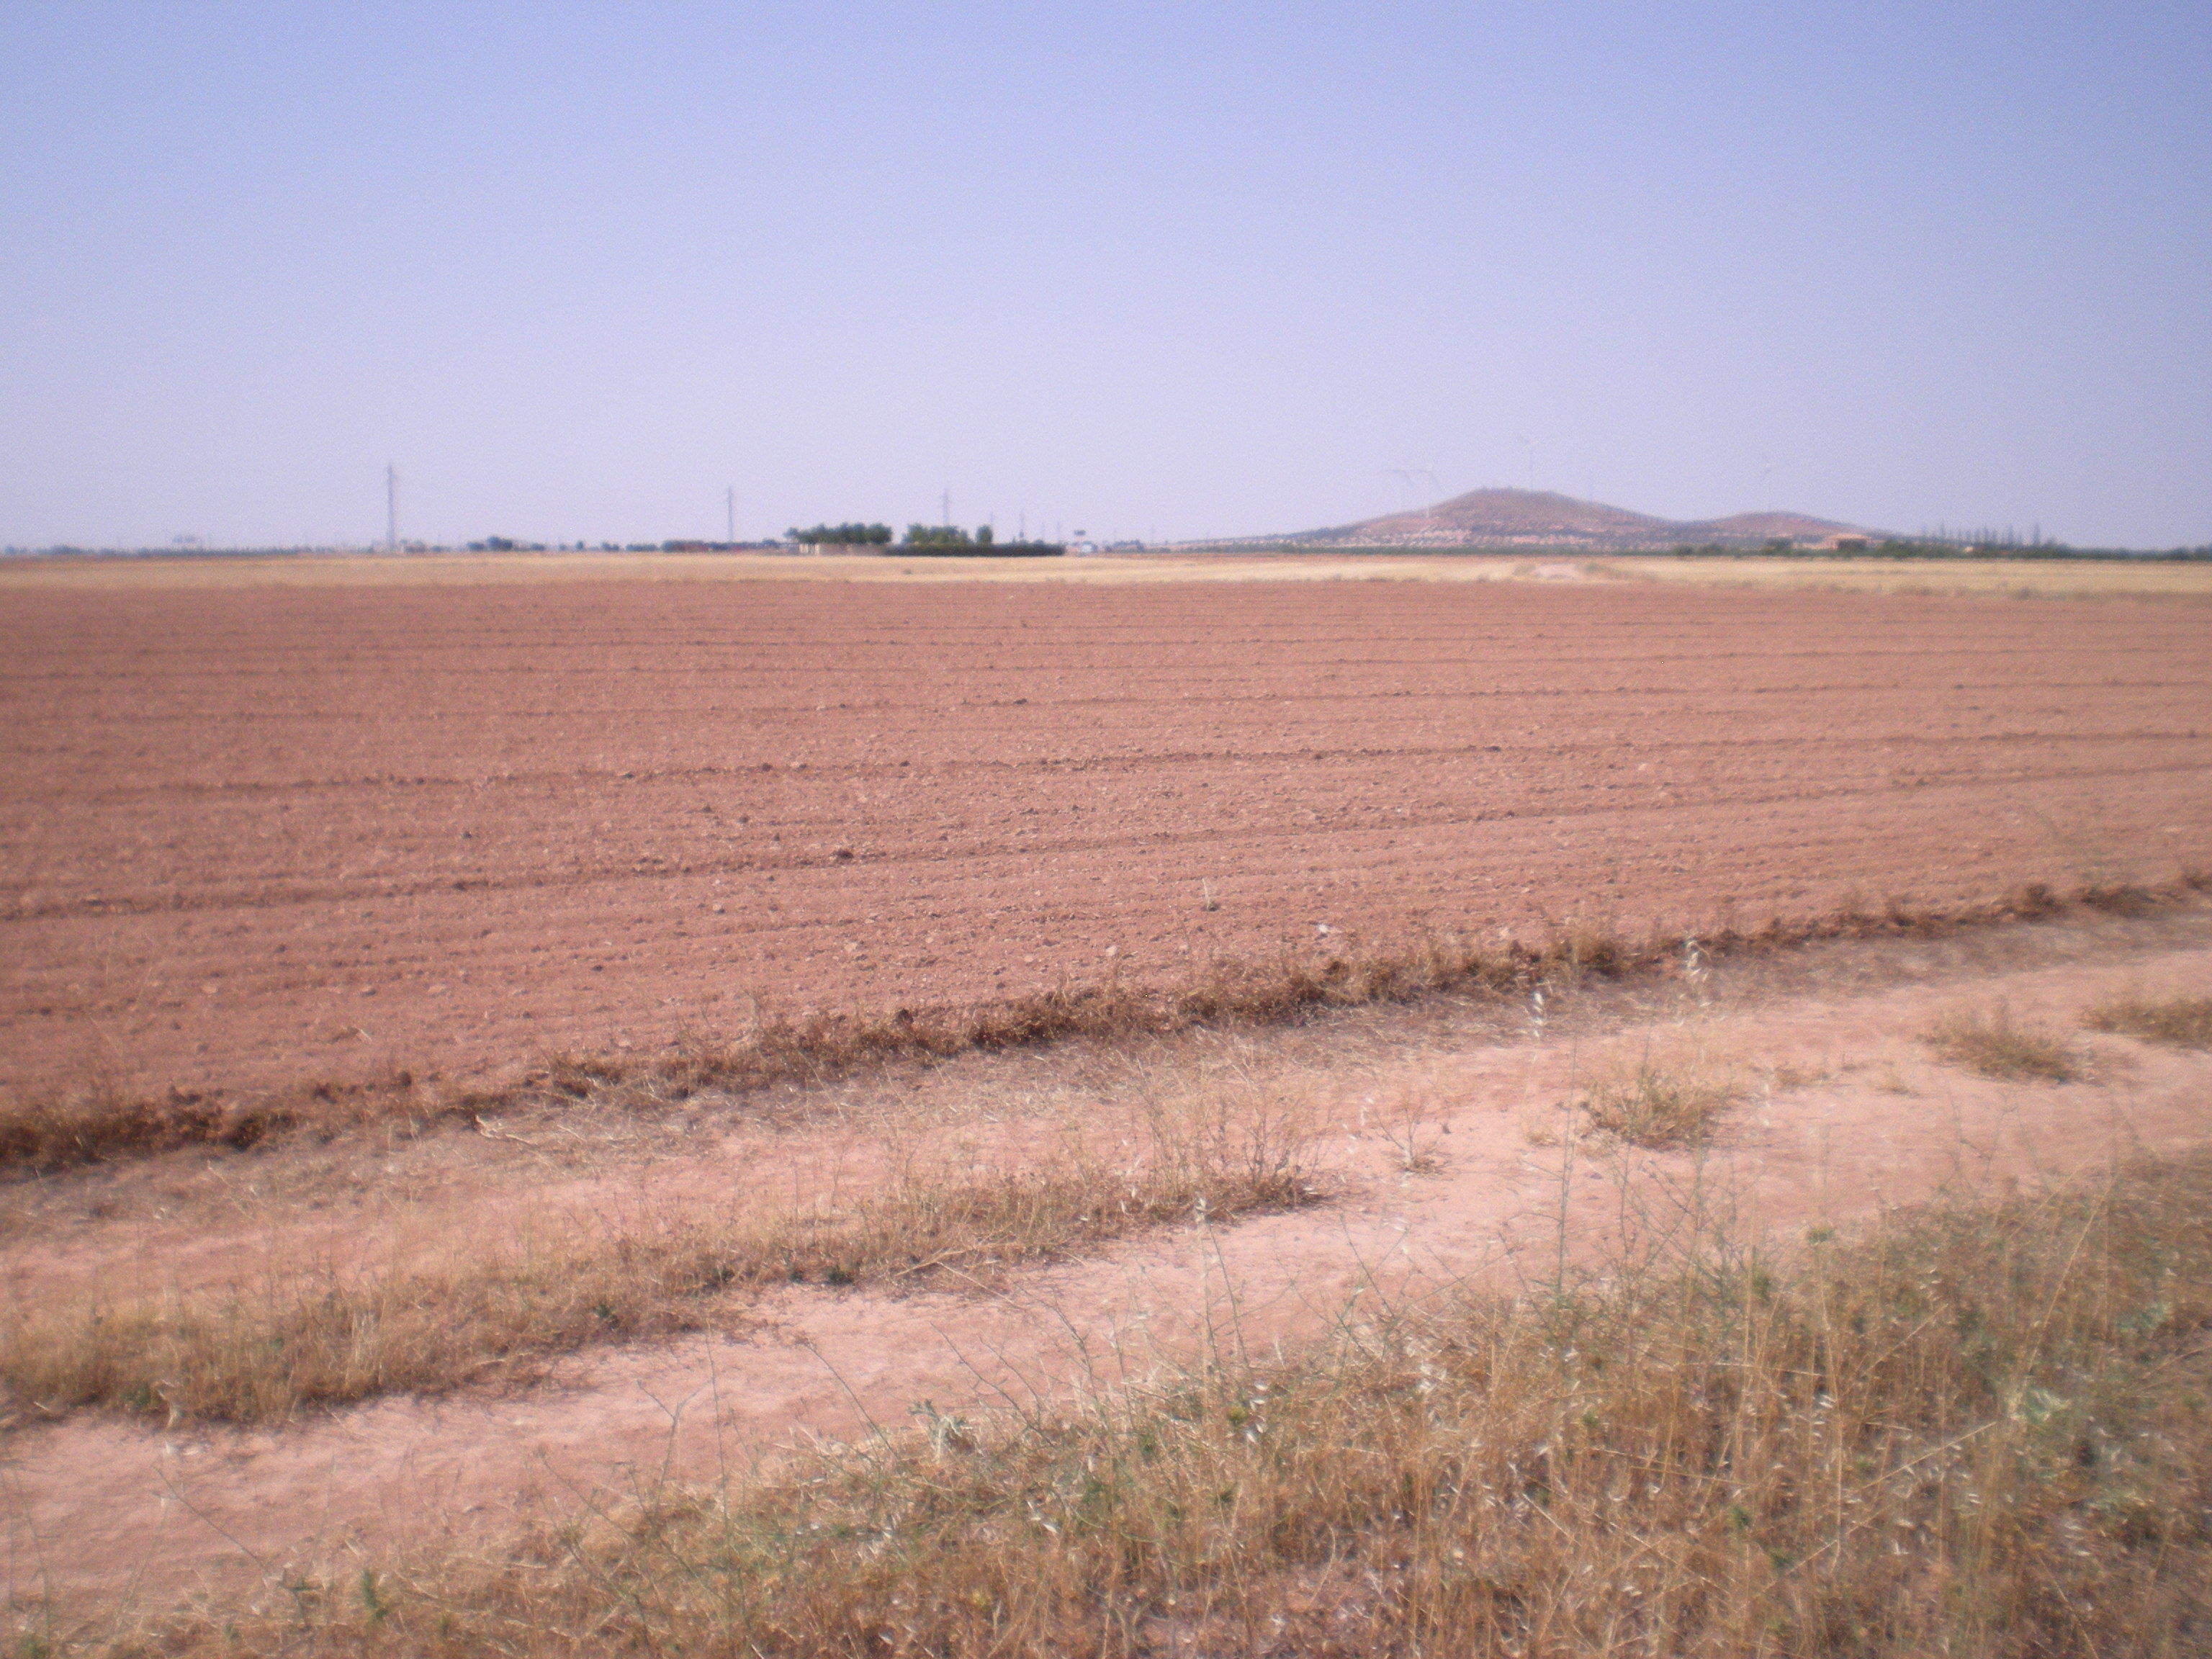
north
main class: Grassland
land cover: Spontaneously vegetated surfaces
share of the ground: 10 - 25 %
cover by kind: unconsolidated bare surface 80 %, herbaceous plants 20 %
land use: Agriculture (excluding fallow land and kitchen gardens)
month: July
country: ES
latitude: 39.4913
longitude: -3.5223
